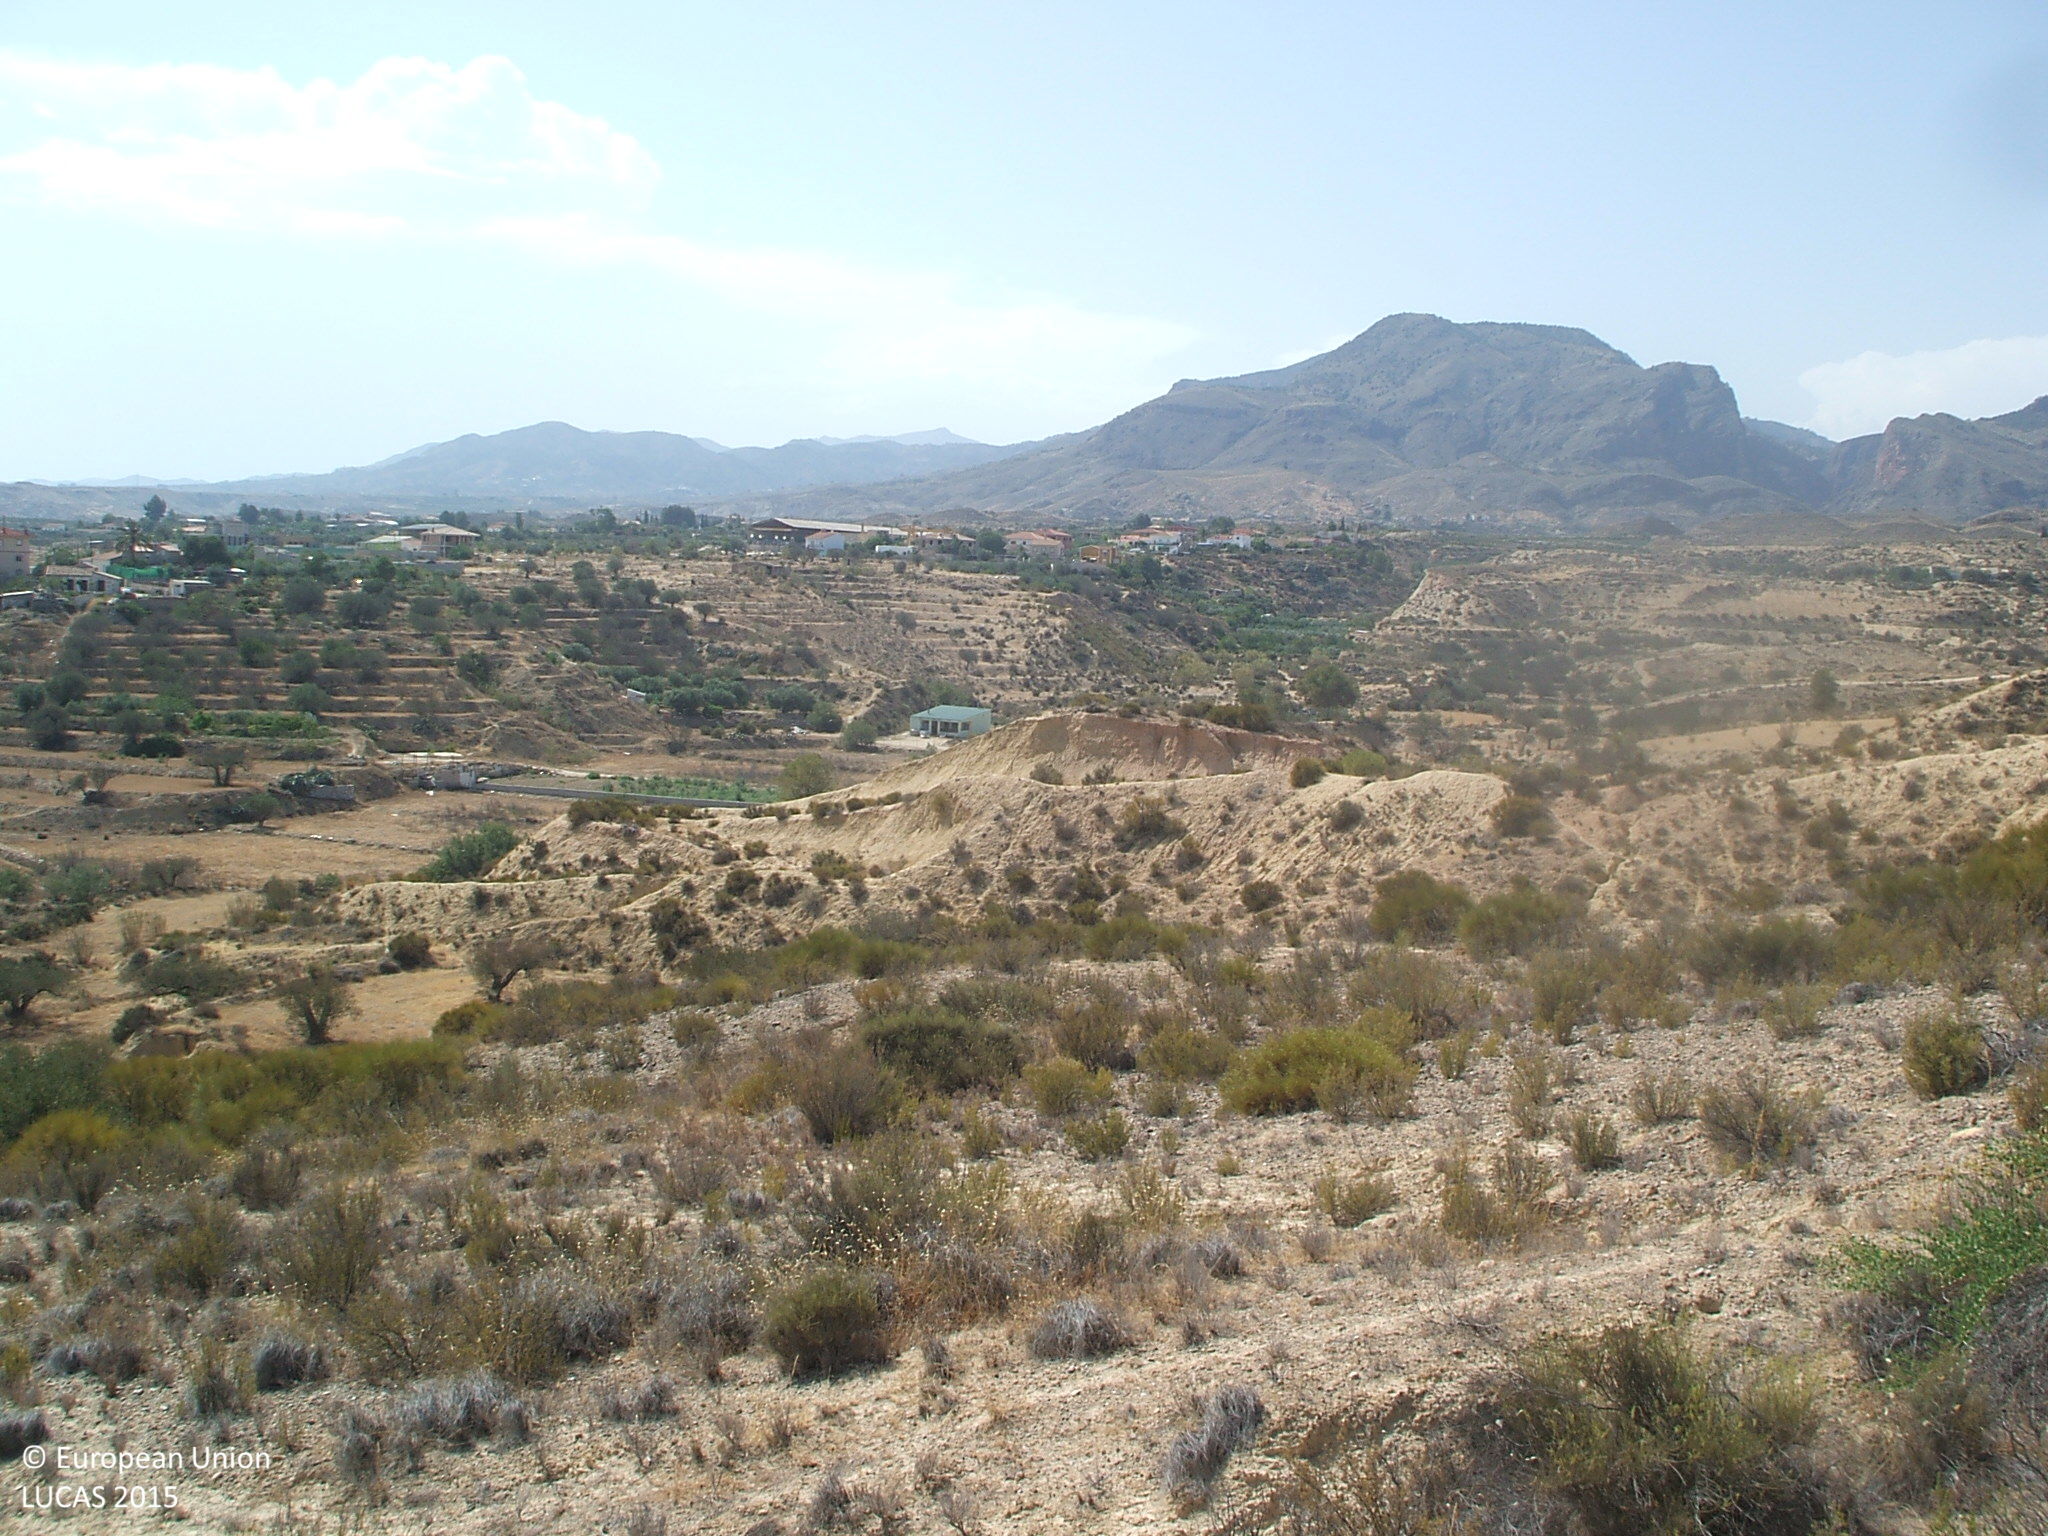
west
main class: Shrubland
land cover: Shrubland without tree cover
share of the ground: 25 - 50 %
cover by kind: consolidated bare surface 50 %, shrubs 40 %, herbaceous plants 10 %
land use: Semi-natural and natural areas not in use
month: July
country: ES
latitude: 37.3671
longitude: -2.3010
